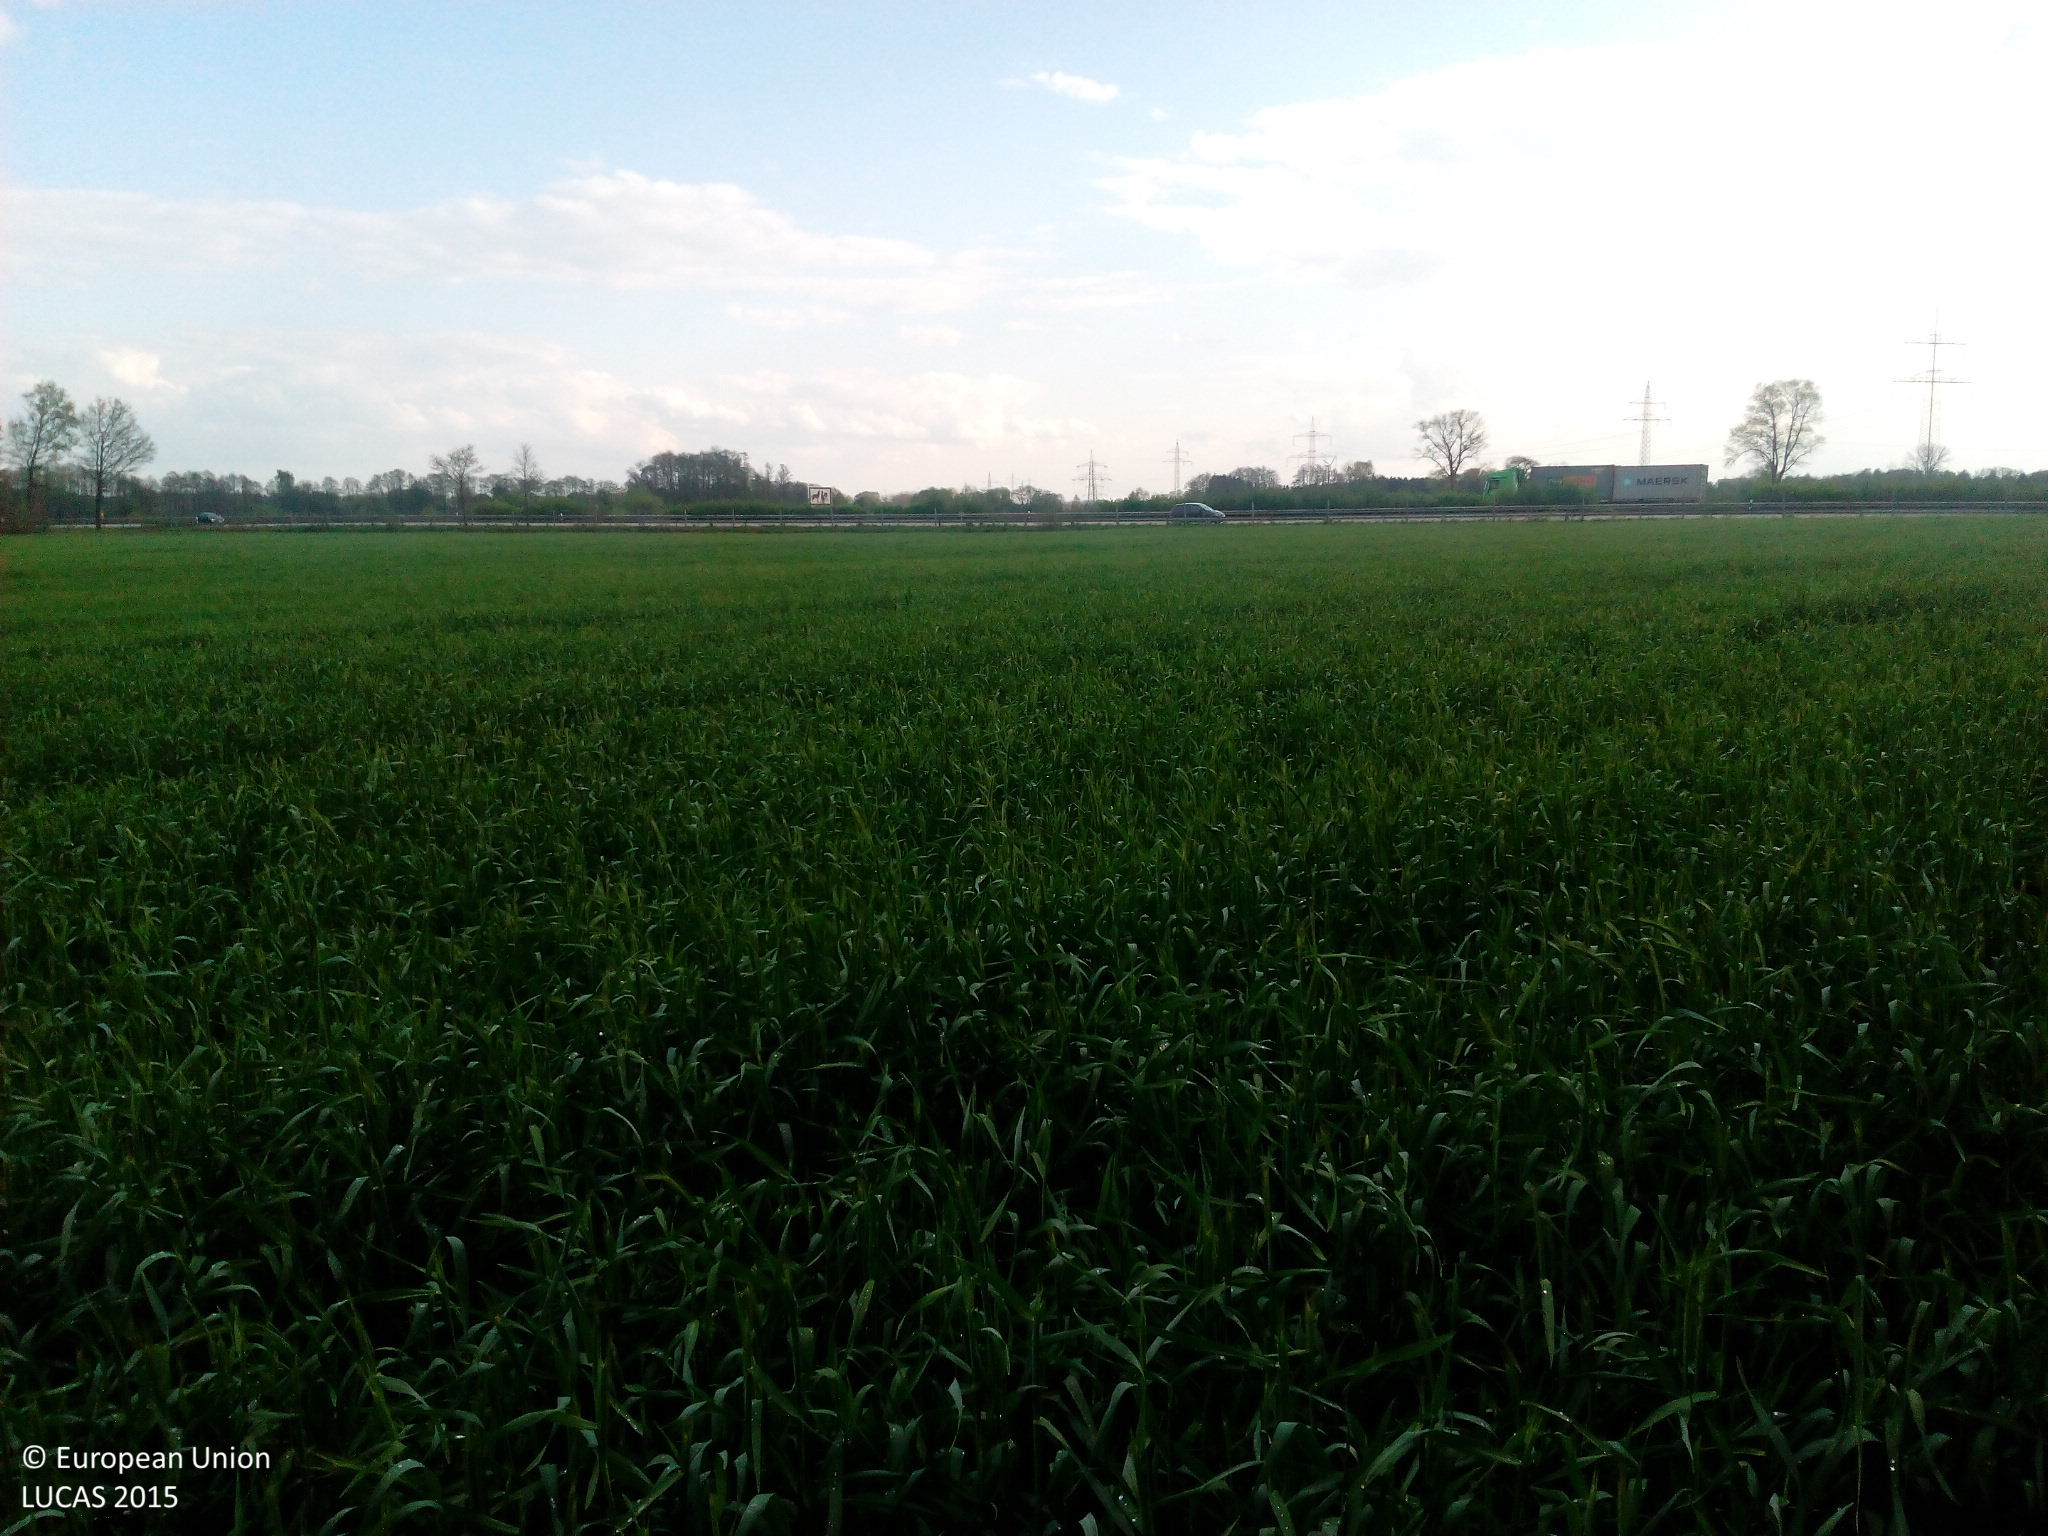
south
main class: Cropland
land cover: Rye
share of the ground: > 75 %
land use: Agriculture (excluding fallow land and kitchen gardens)
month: May
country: DE
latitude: 52.9860
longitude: 9.2109
